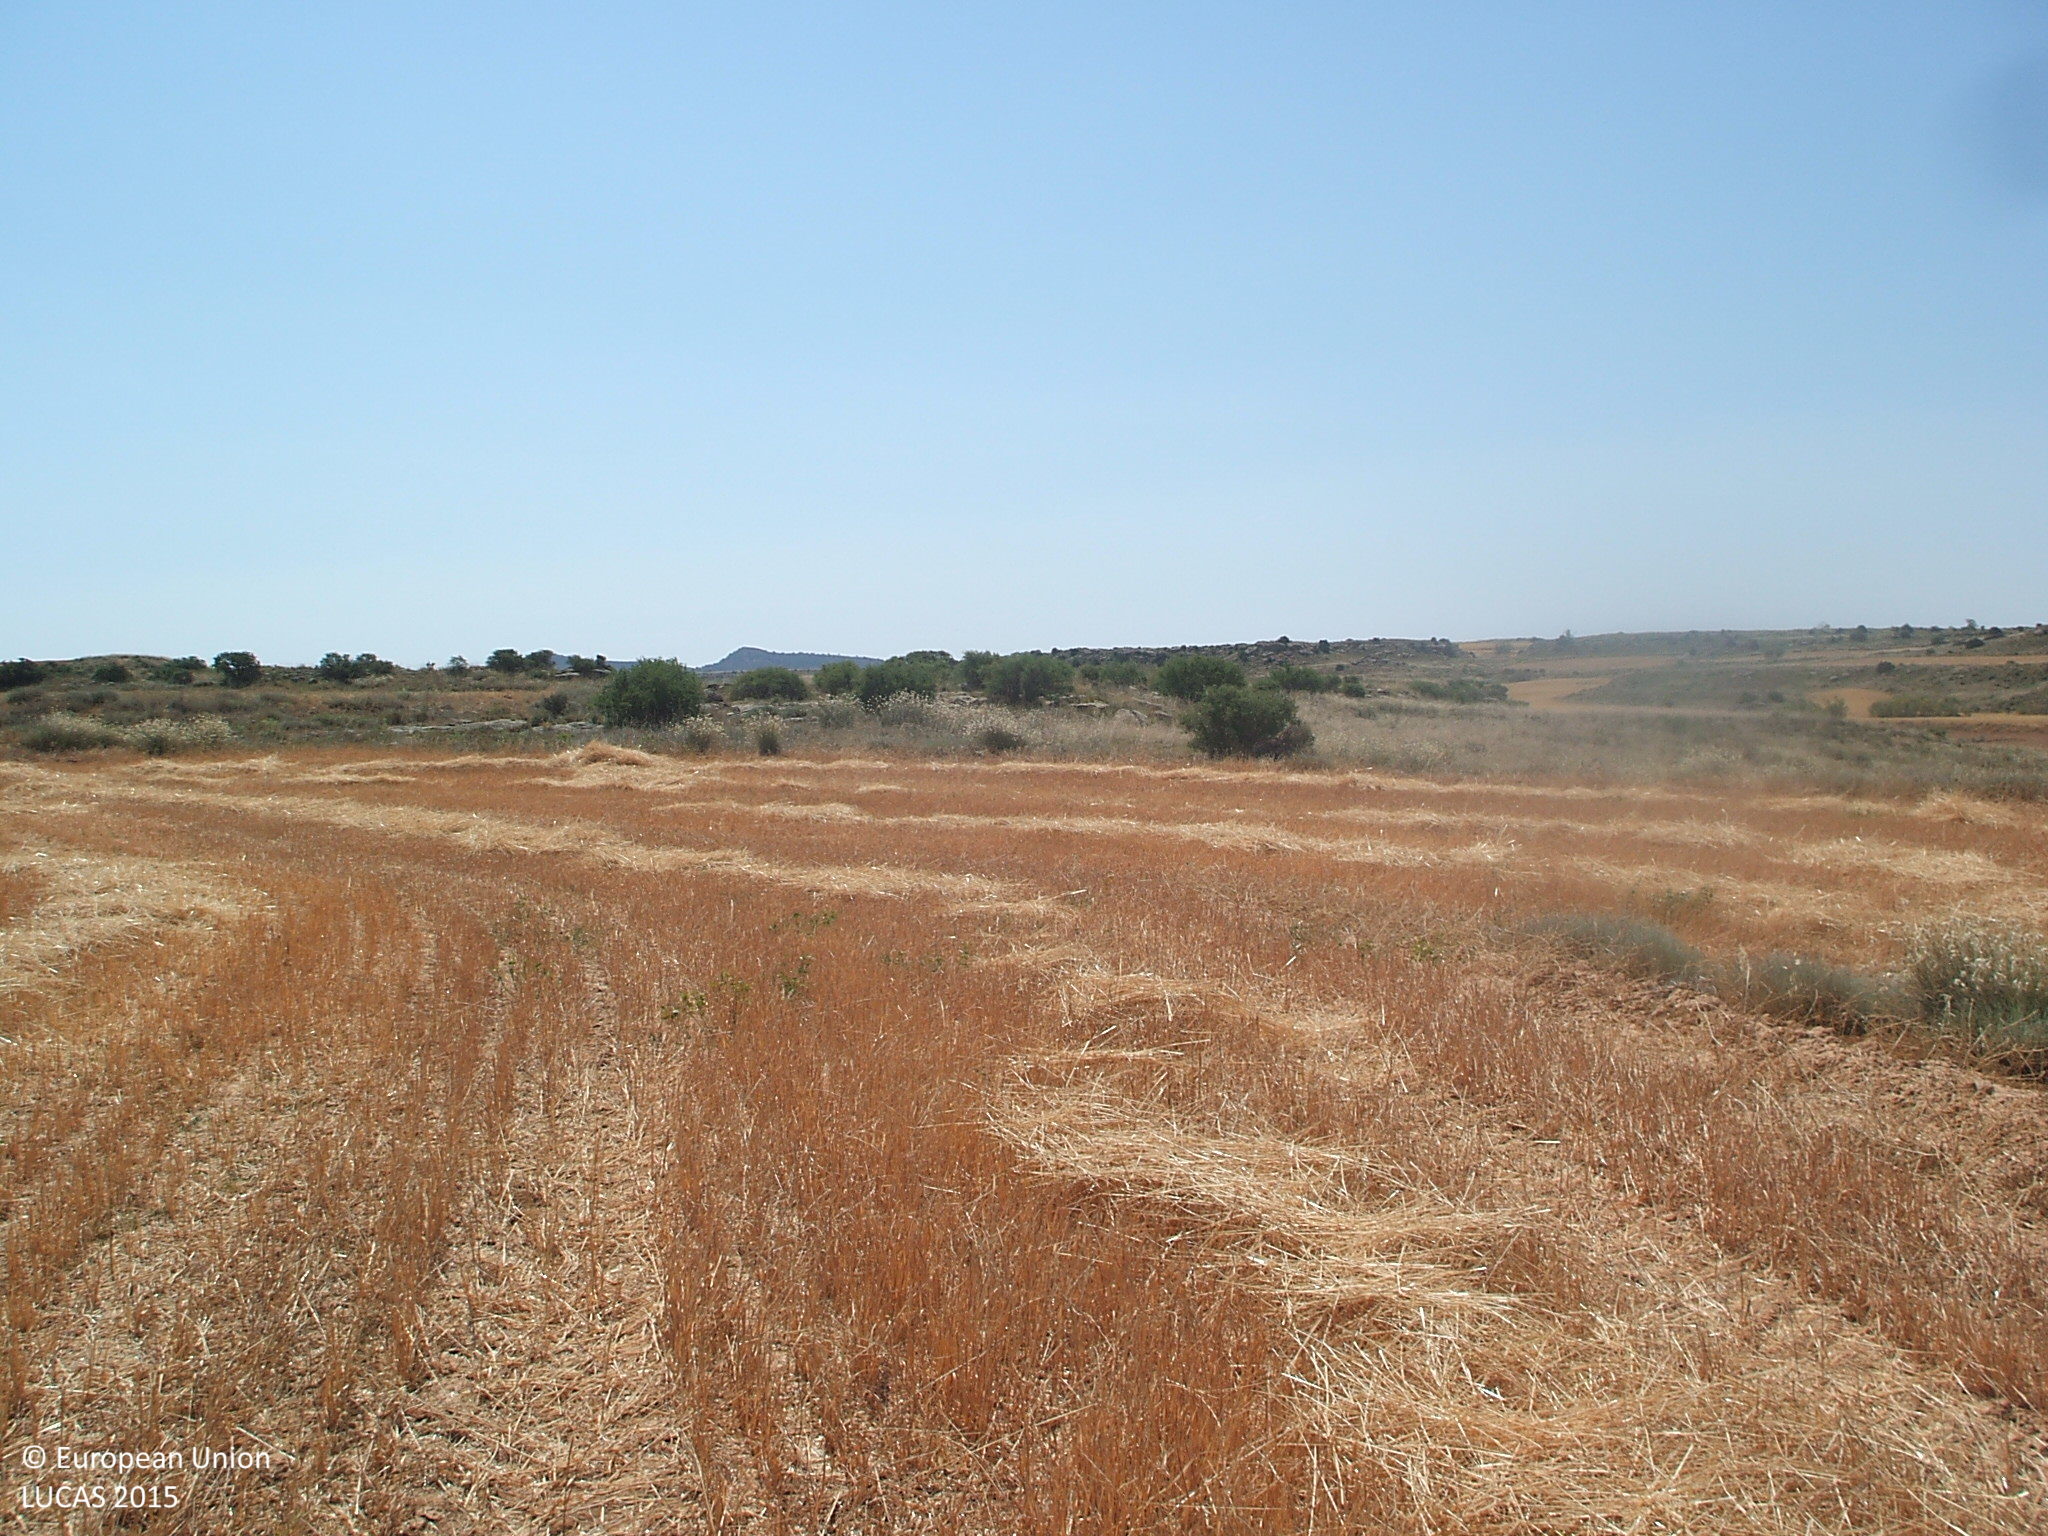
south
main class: Cropland
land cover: Barley
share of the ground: < 10 %
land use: Agriculture (excluding fallow land and kitchen gardens)
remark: Harvested field
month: June
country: ES
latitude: 41.1631
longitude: -0.2985
